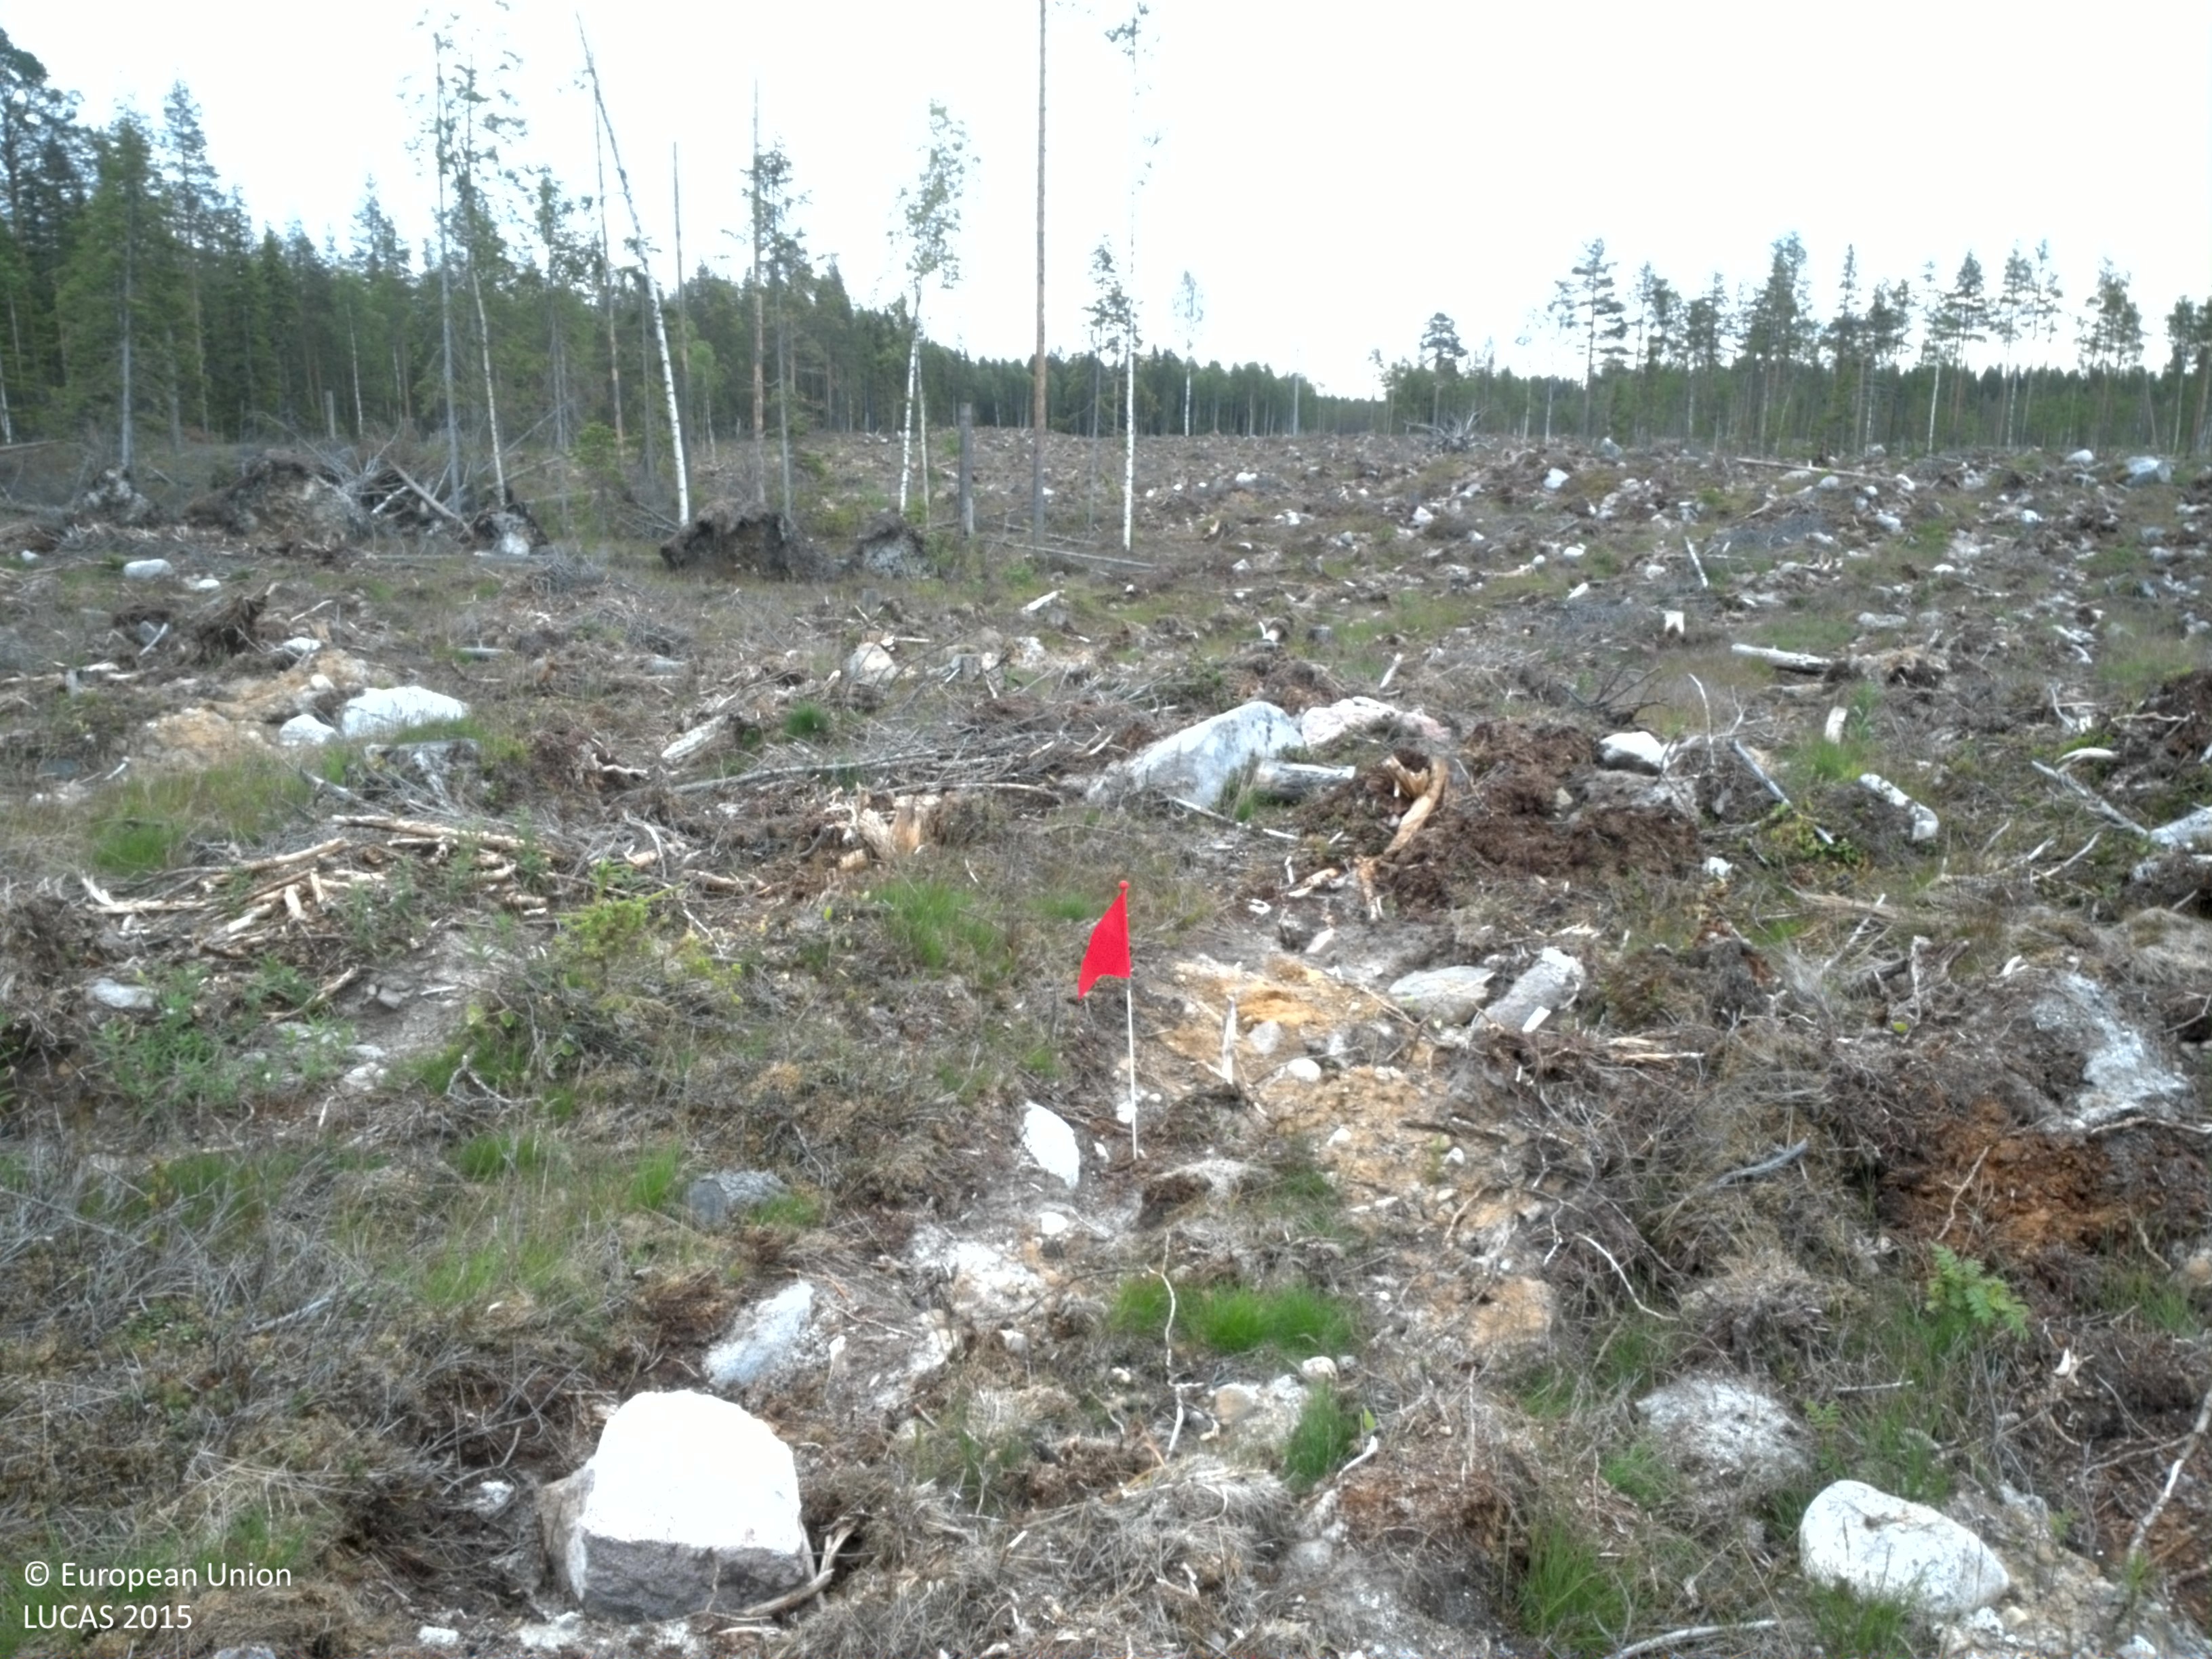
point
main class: Grassland
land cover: Grassland with sparse tree/shrub cover
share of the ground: 50 - 75 %
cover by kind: herbaceous plants 65 %, unconsolidated bare surface 20 %, shrubs 10 %, broadleaved forest trees 5 %
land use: Forestry
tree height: > 5 m
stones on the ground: 25 - 50 %
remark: Clear cut
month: July
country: SE
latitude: 64.4416
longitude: 20.6359
